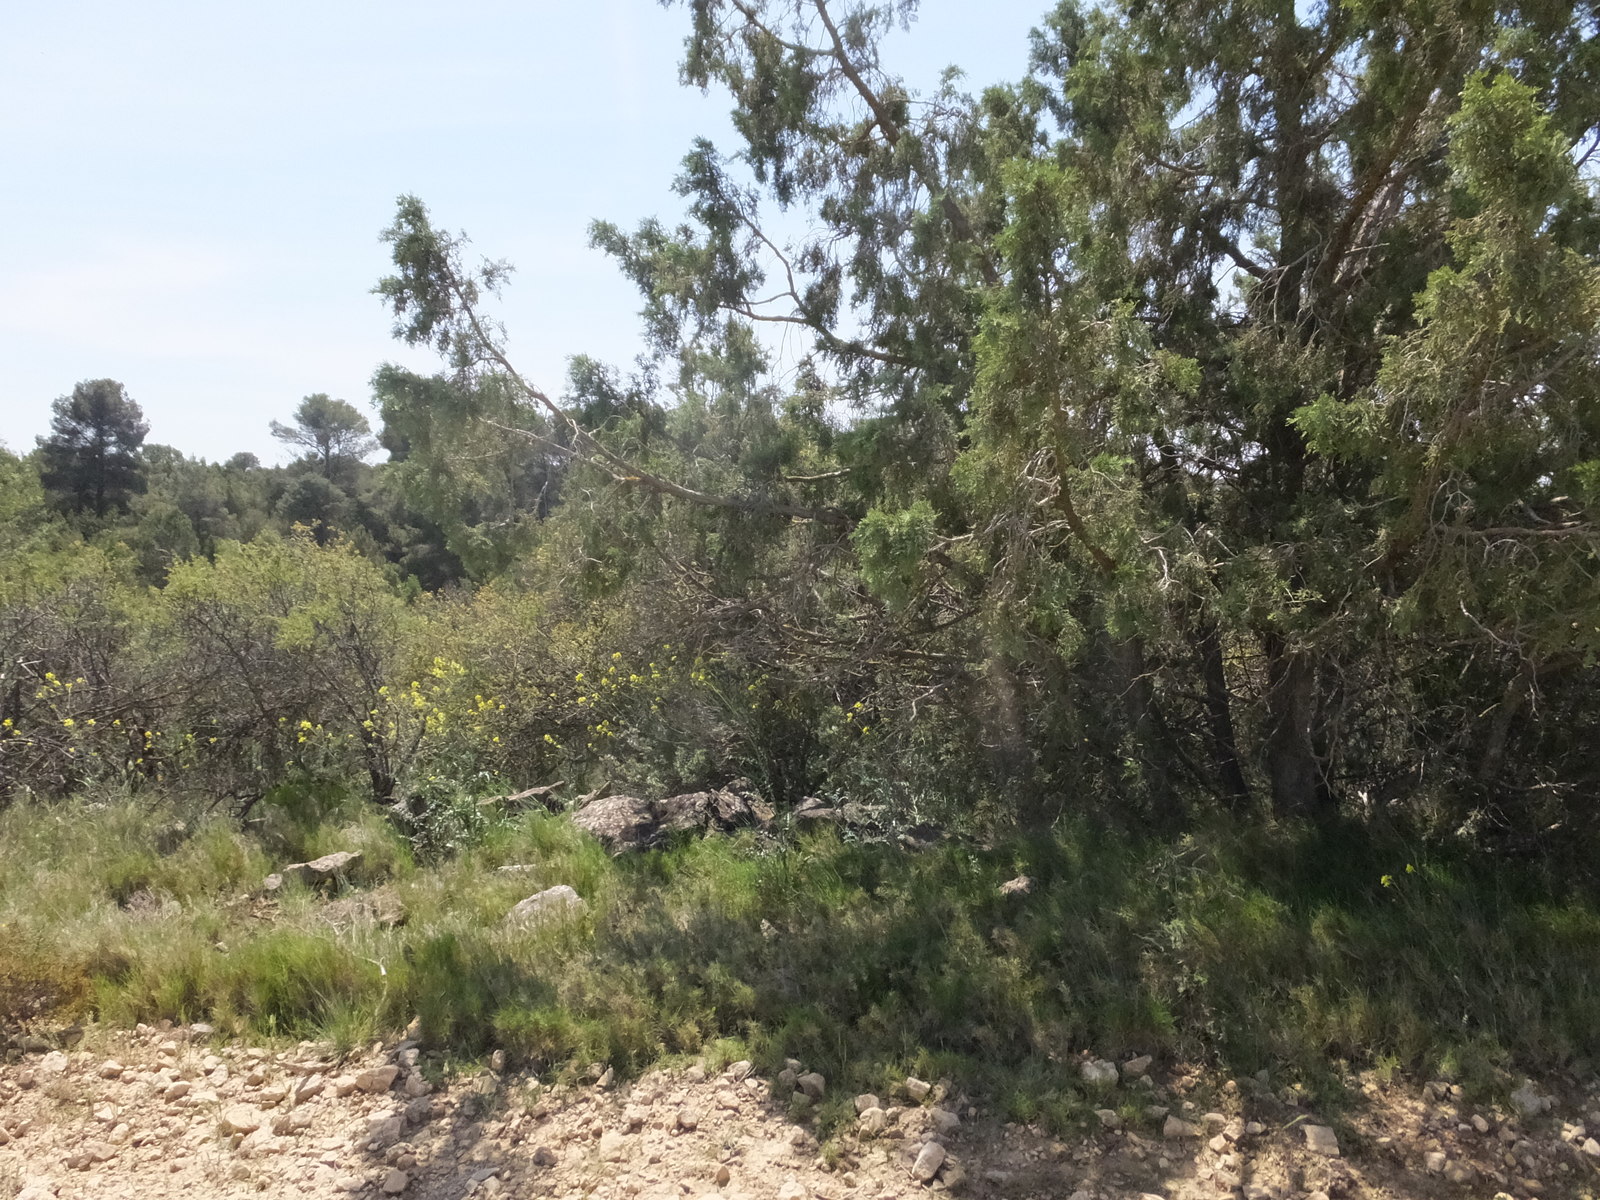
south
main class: Cropland
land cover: Lucerne
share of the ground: > 75 %
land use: Agriculture (excluding fallow land and kitchen gardens)
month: April
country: ES
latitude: 41.6511
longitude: -0.3323
